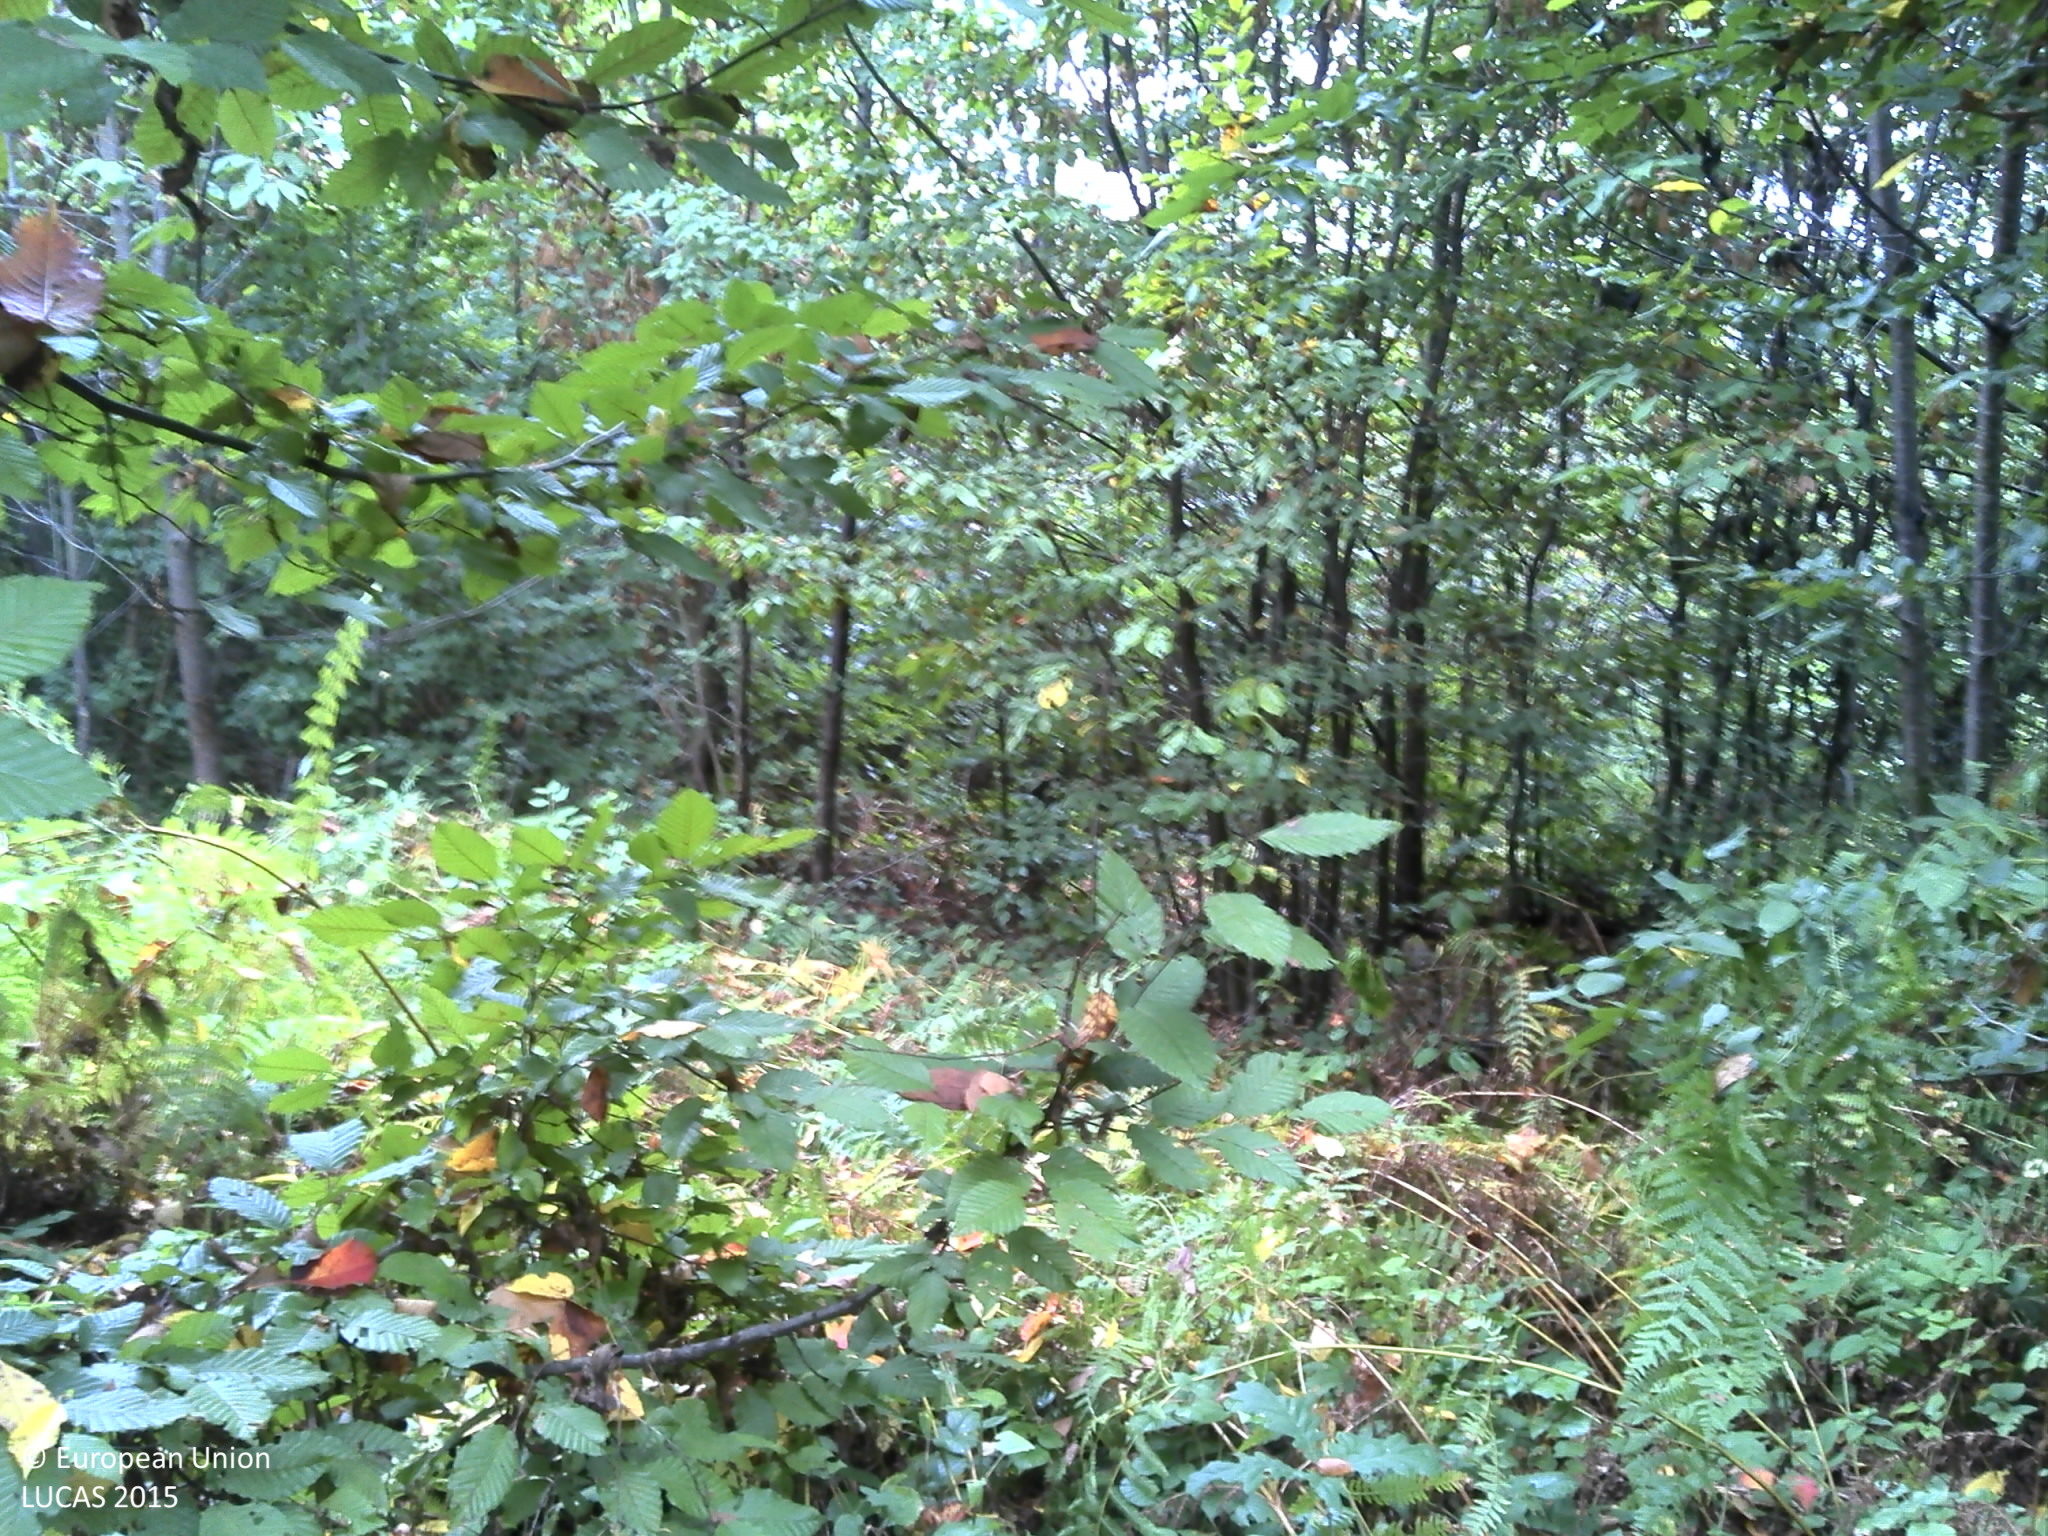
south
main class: Woodland
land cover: Broadleaved woodland
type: beech forest
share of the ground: > 75 %
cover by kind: broadleaved forest trees 100 %
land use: Forestry
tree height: > 5 m
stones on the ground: < 10 %
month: August
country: HR
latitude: 45.2450
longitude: 15.9714
